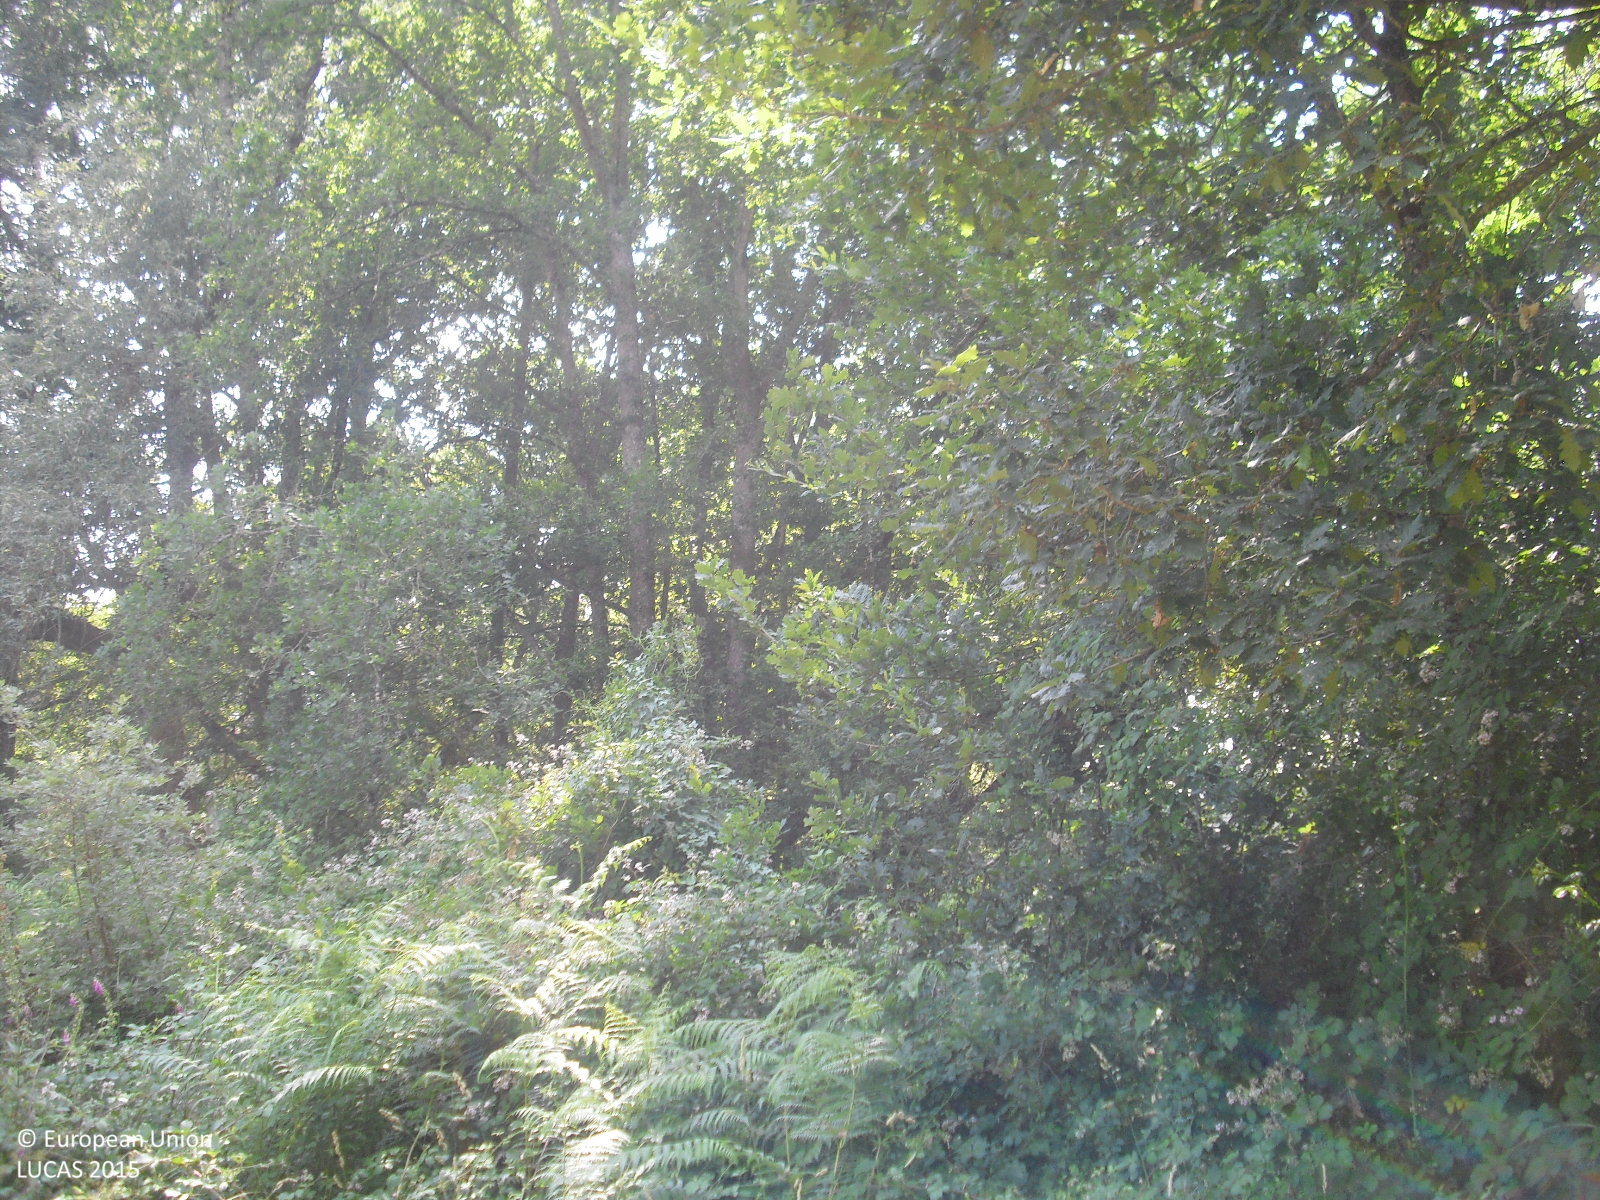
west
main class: Cropland
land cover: Temporary grasslands
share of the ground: > 75 %
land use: Agriculture (excluding fallow land and kitchen gardens)
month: June
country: ES
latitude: 42.6308
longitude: -7.7970
